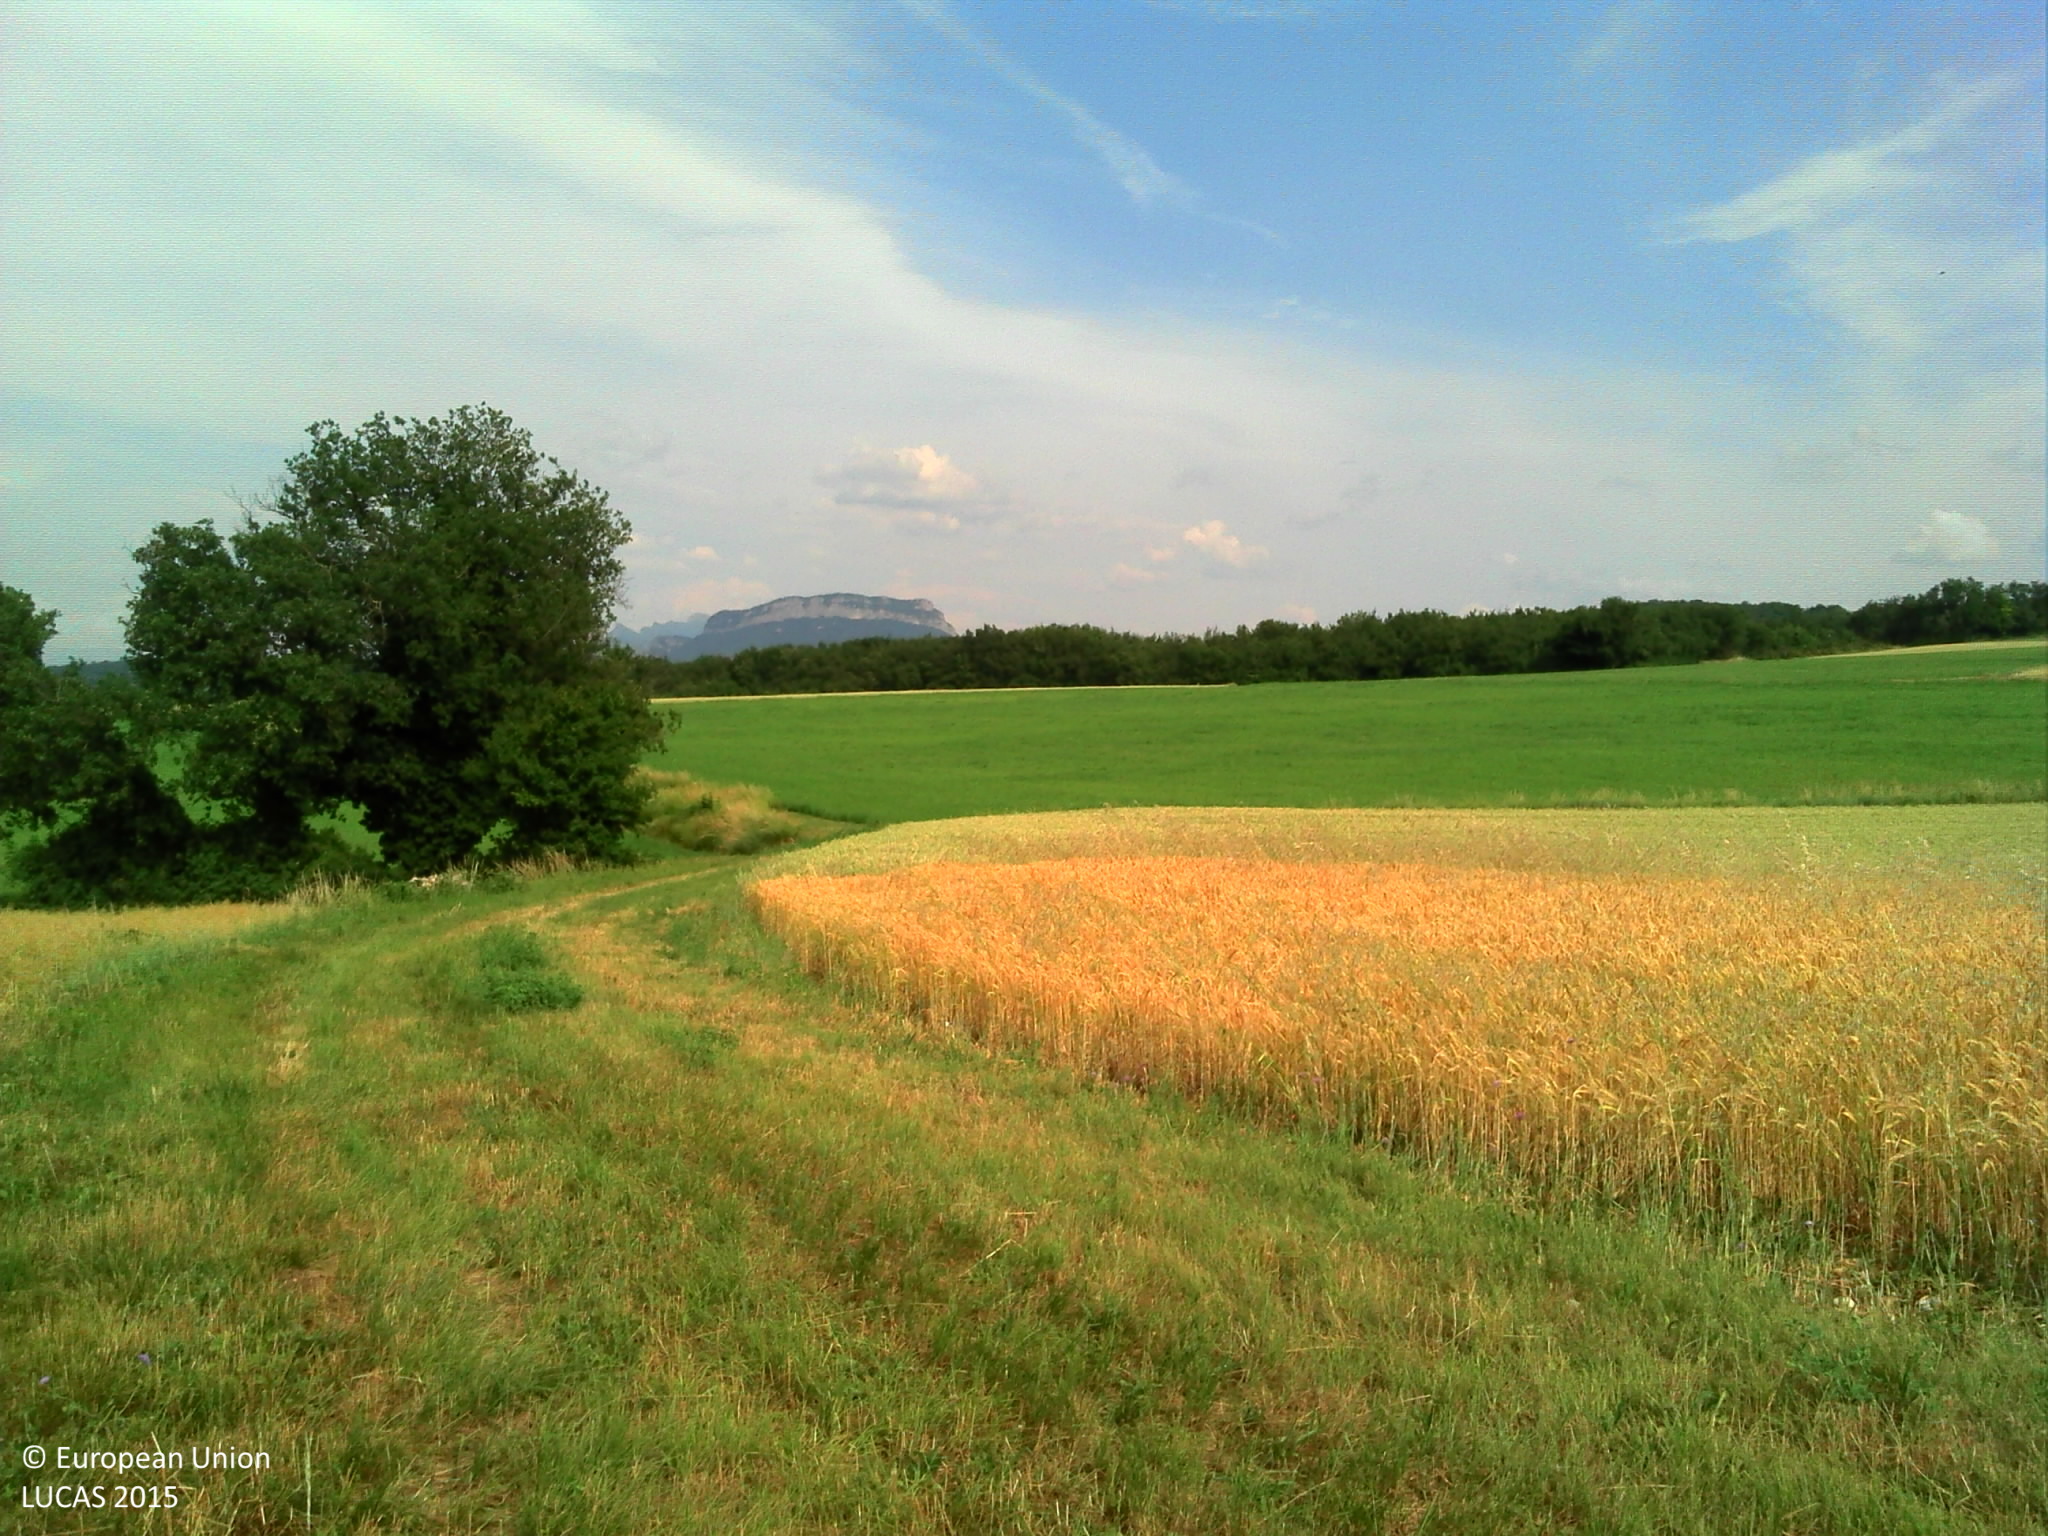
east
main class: Cropland
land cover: Rape and turnip rape
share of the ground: > 75 %
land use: Agriculture (excluding fallow land and kitchen gardens)
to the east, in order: Rape and turnip rape; Ditches and canals; Lucerne
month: June
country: FR
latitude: 44.6792
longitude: 4.9476
